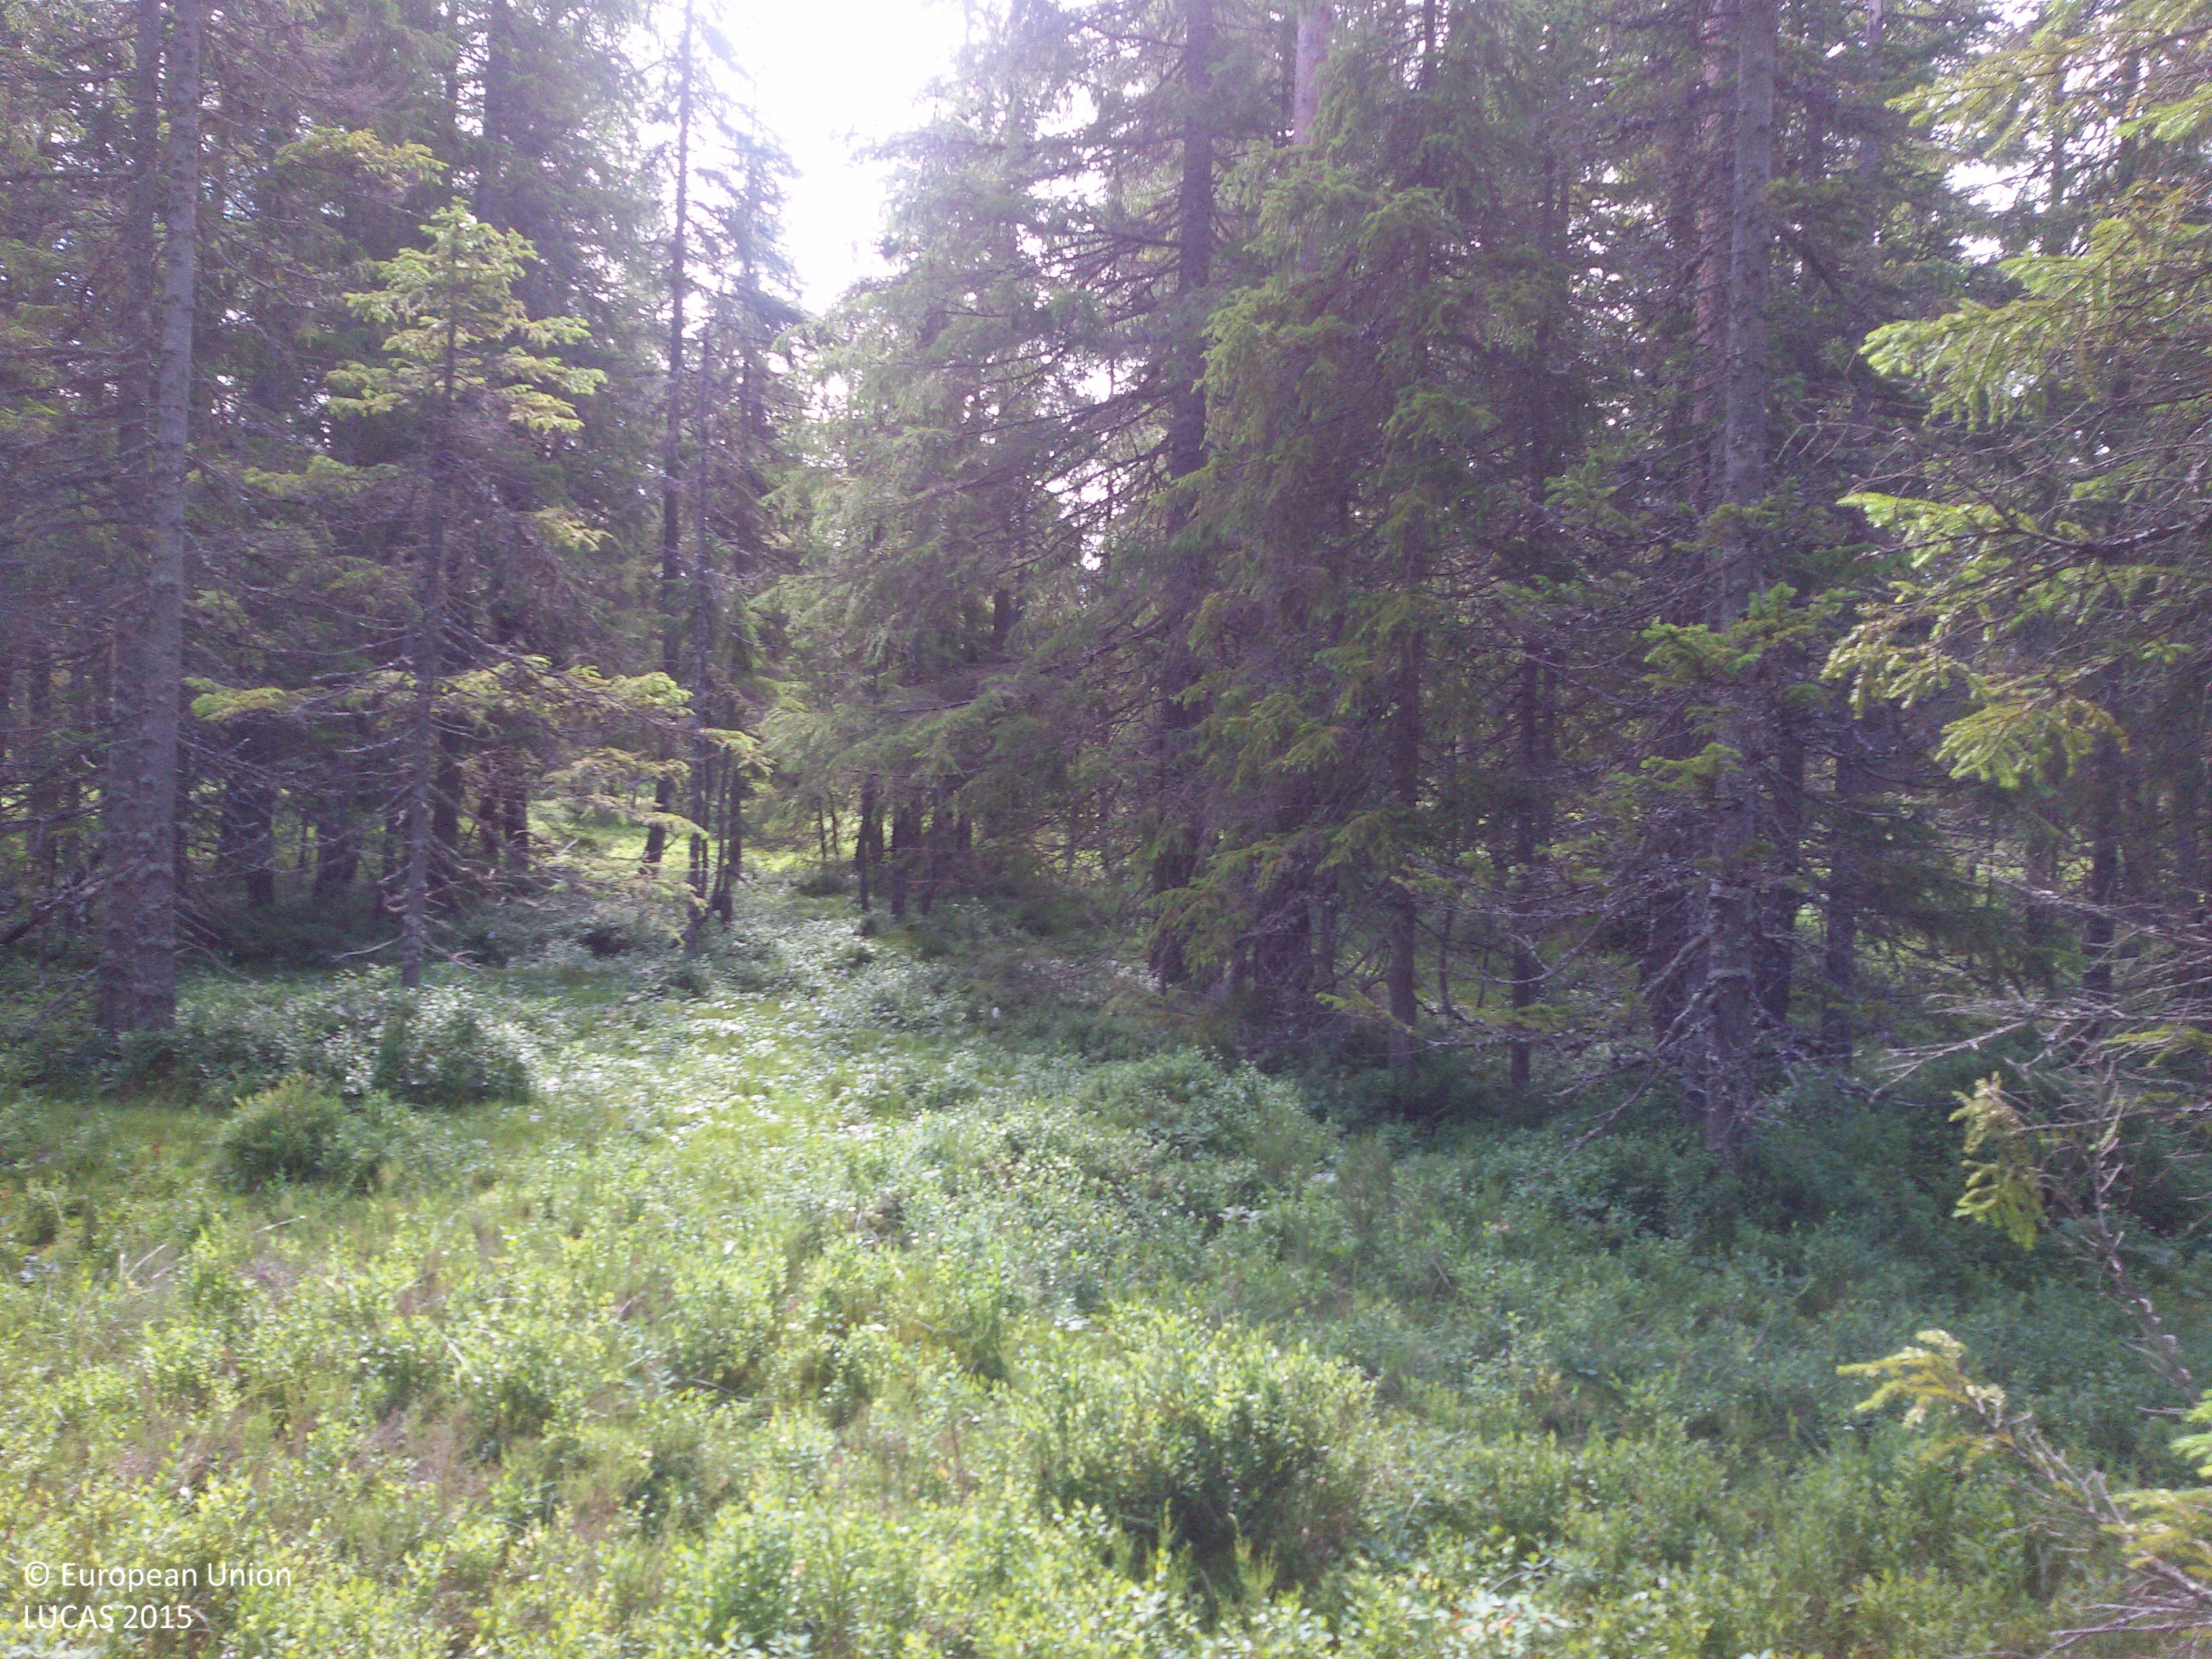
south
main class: Woodland
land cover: Spruce dominated coniferous woodland
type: boreal forest
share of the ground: 50 - 75 %
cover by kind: coniferous forest trees 65 %, shrubs 35 %
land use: Forestry
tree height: > 5 m
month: July
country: SE
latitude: 60.4316
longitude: 15.0930
